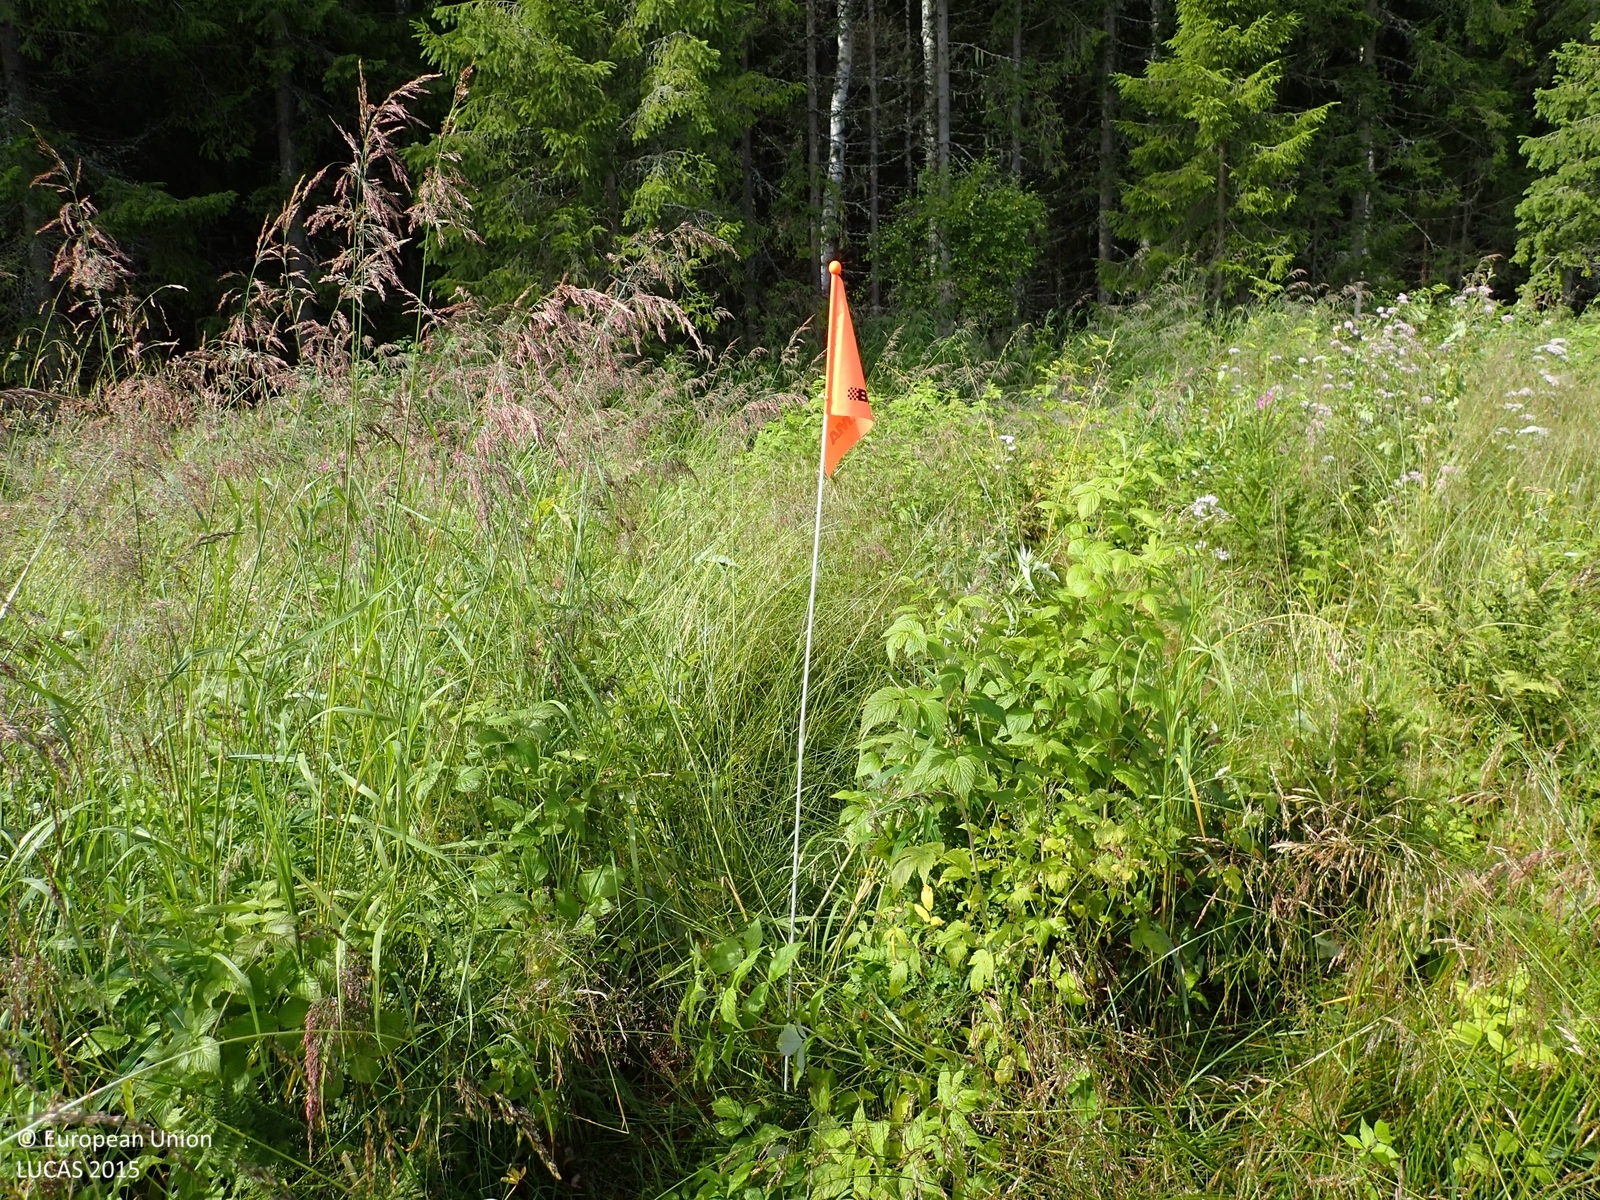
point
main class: Grassland
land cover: Grassland with sparse tree/shrub cover
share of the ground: > 75 %
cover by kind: herbaceous plants 95 %, broadleaved forest trees 5 %
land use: Forestry
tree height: < 5 m
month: July
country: FI
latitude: 62.9341
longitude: 22.6819
